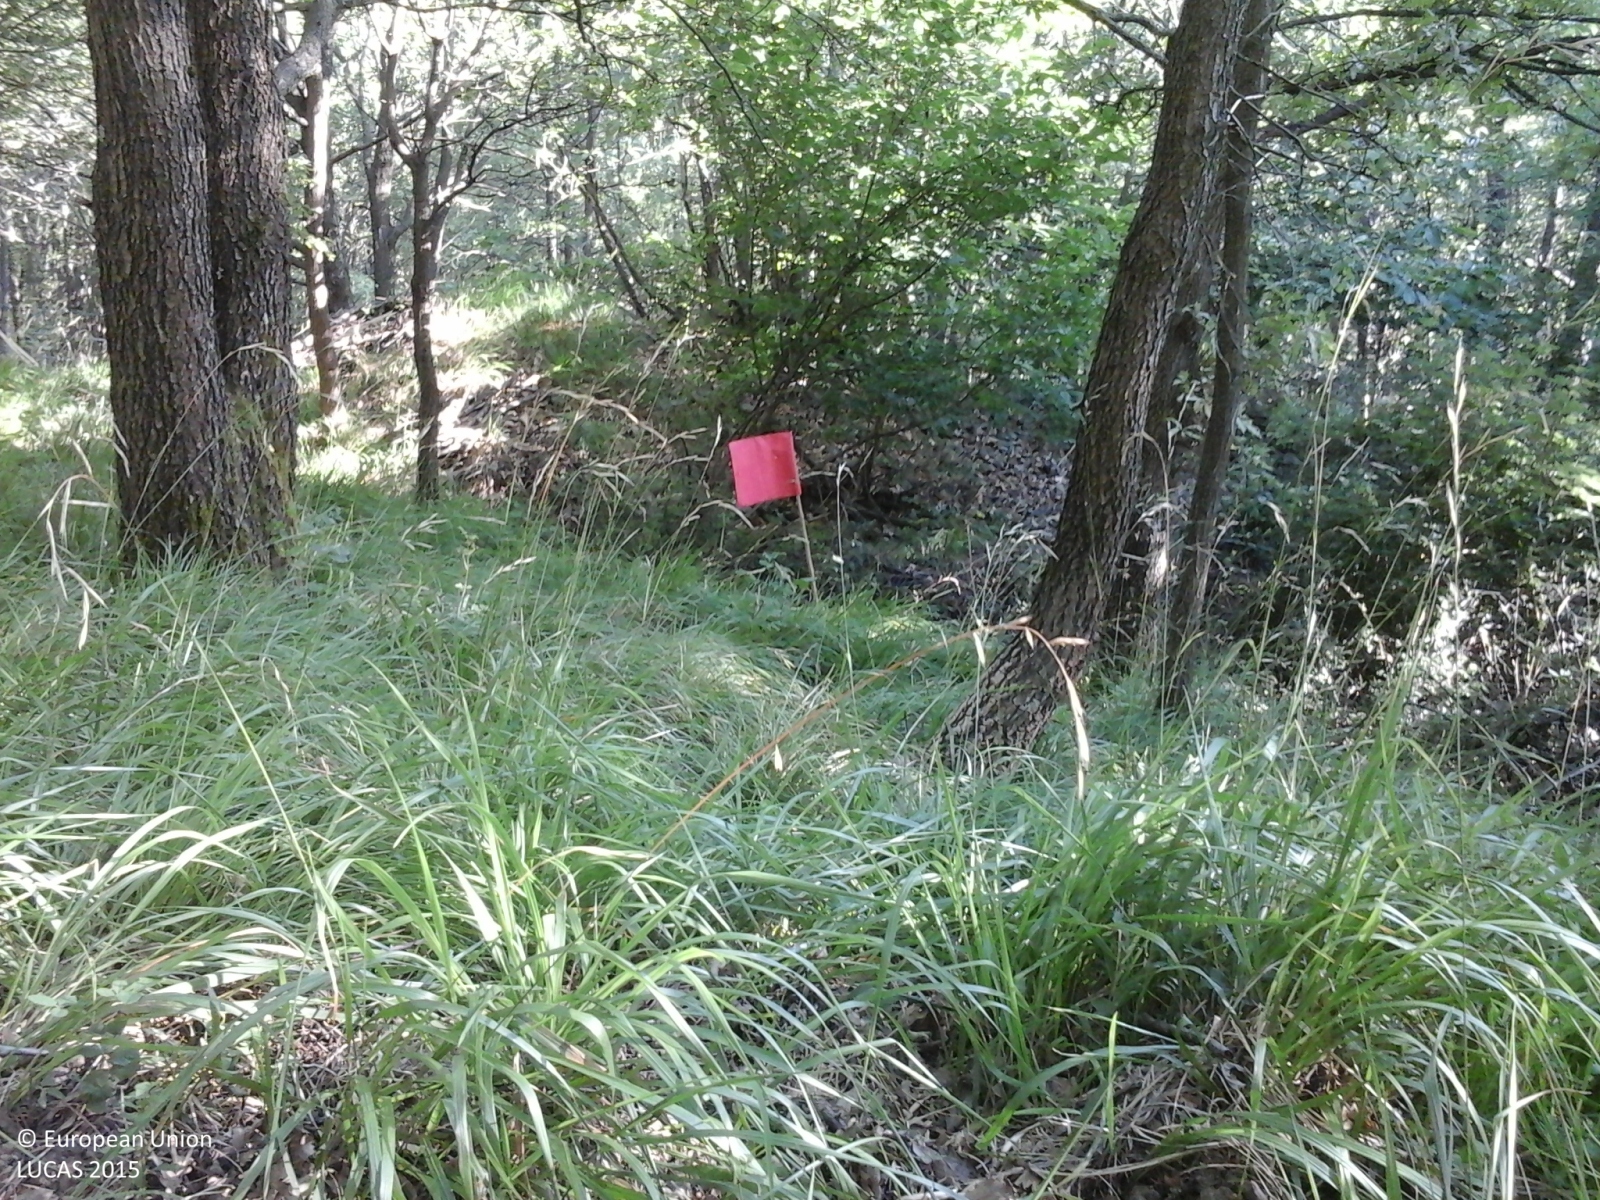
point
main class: Woodland
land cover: Broadleaved woodland
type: thermophilous deciduous forest
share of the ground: > 75 %
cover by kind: broadleaved forest trees 100 %
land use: Forestry
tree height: > 5 m
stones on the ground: < 10 %
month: June
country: IT
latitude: 44.6323
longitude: 8.8050
